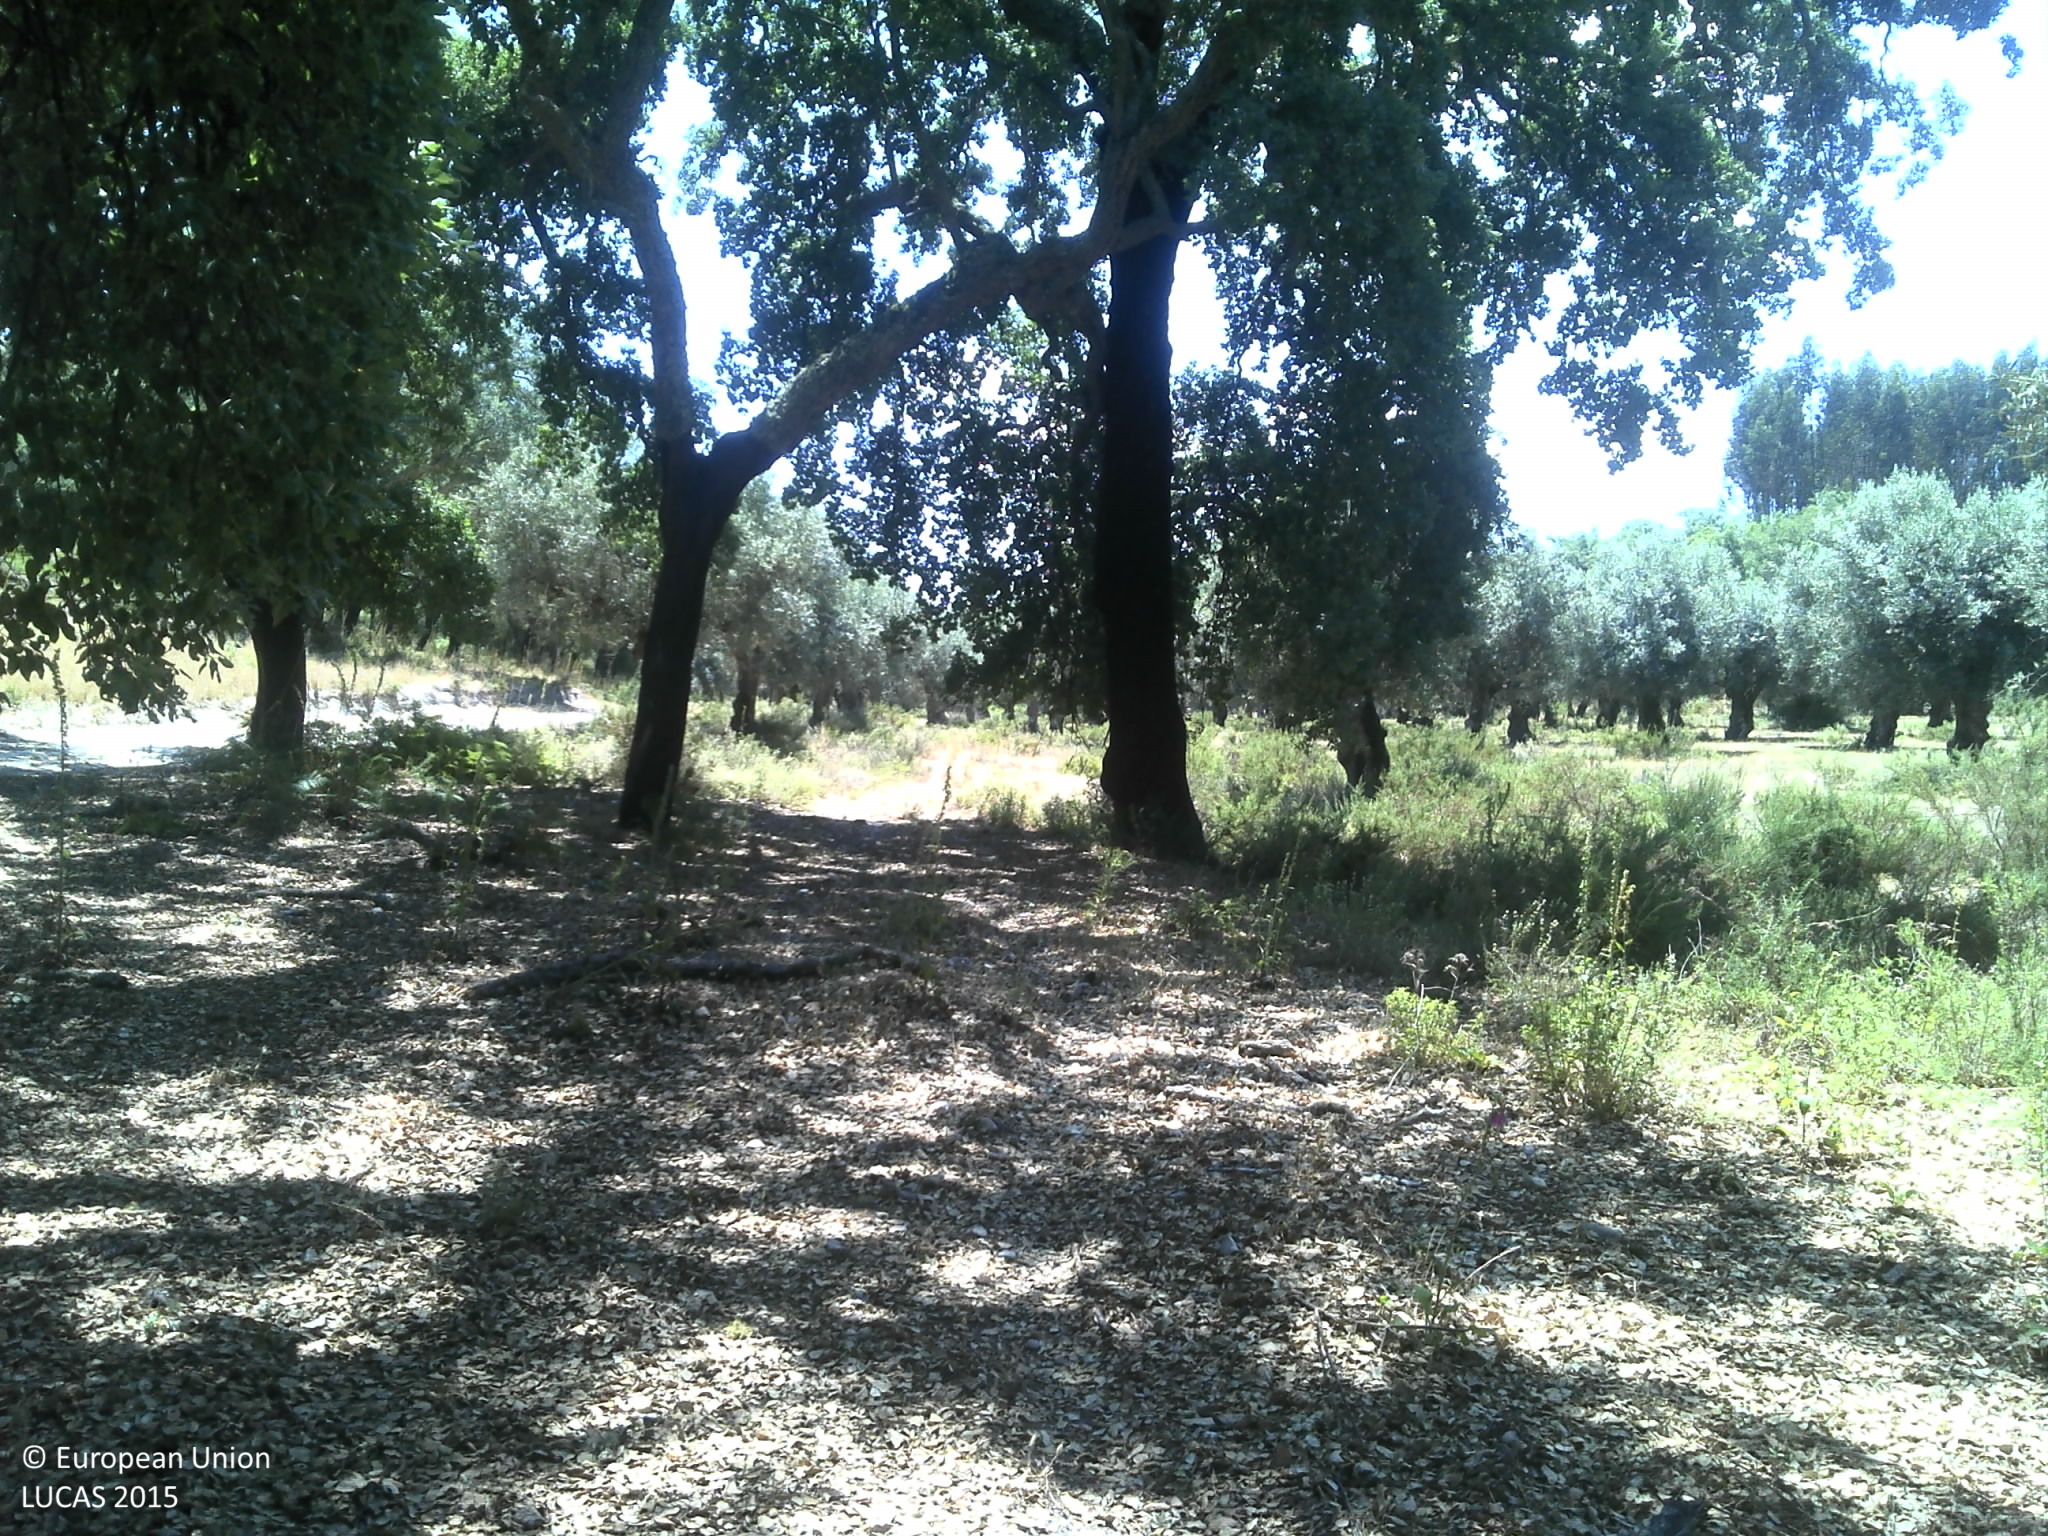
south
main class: Woodland
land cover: Broadleaved woodland
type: broadleaved evergreen forest
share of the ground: 25 - 50 %
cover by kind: broadleaved forest trees 50 %, unconsolidated bare surface 40 %, herbaceous plants 10 %
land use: Forestry
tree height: > 5 m
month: June
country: PT
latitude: 39.3096
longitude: -8.2826
